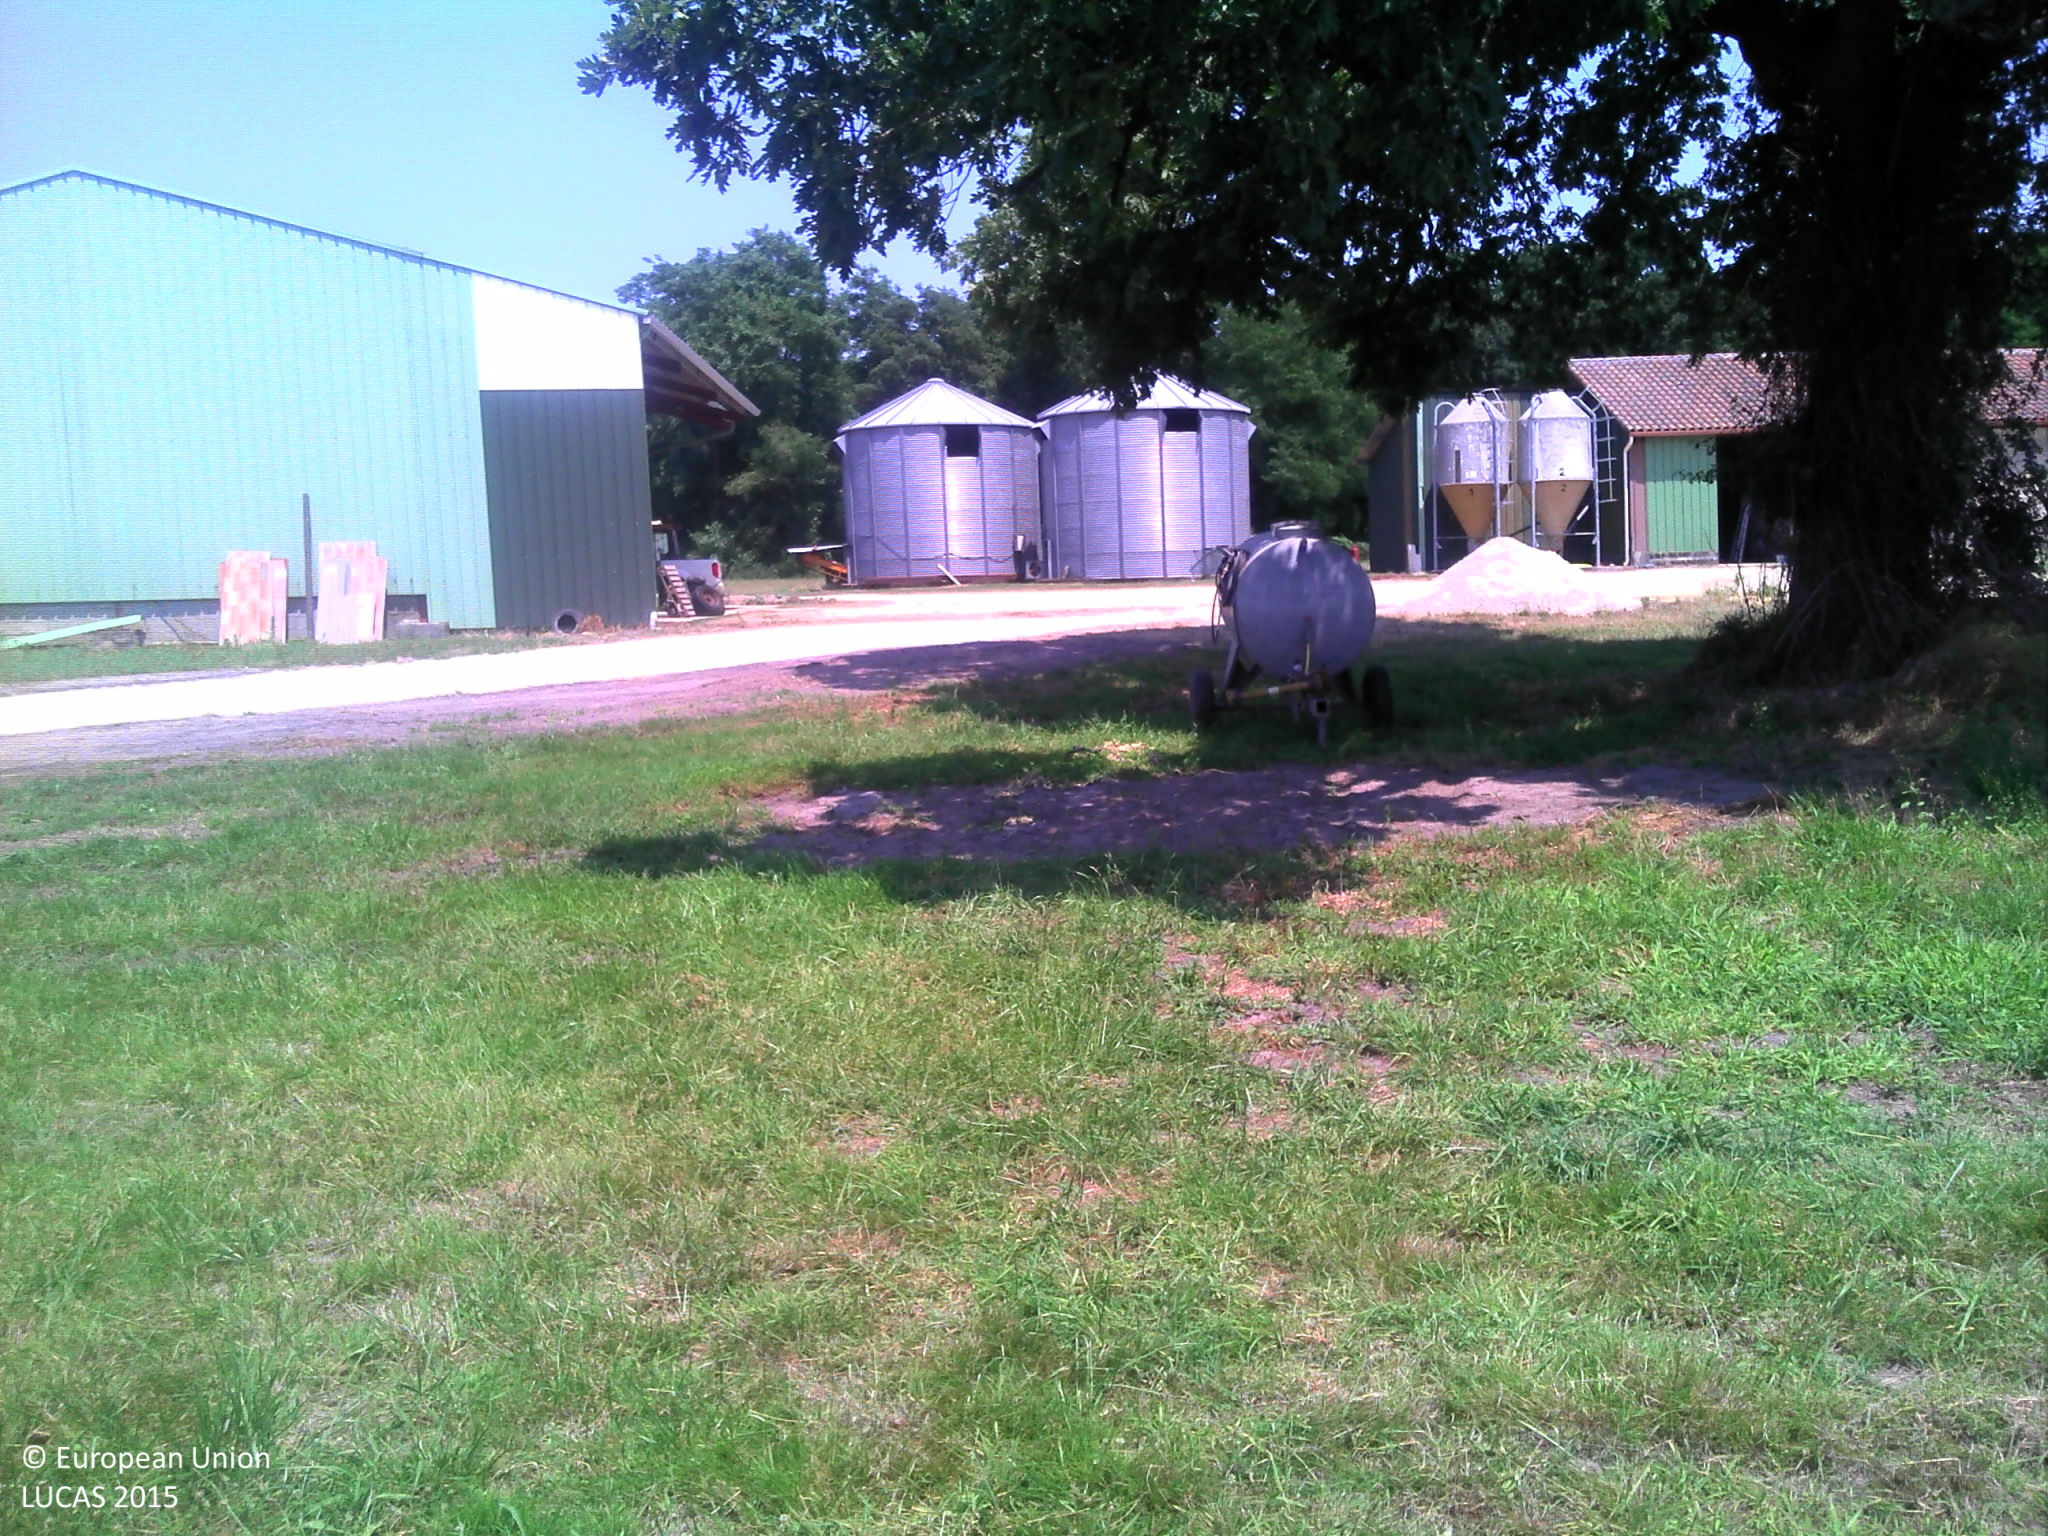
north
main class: Grassland
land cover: Grassland with sparse tree/shrub cover
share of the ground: > 75 %
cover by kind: herbaceous plants 95 %, broadleaved forest trees 5 %
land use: Agriculture (excluding fallow land and kitchen gardens)
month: June
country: FR
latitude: 43.9671
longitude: -0.2683
